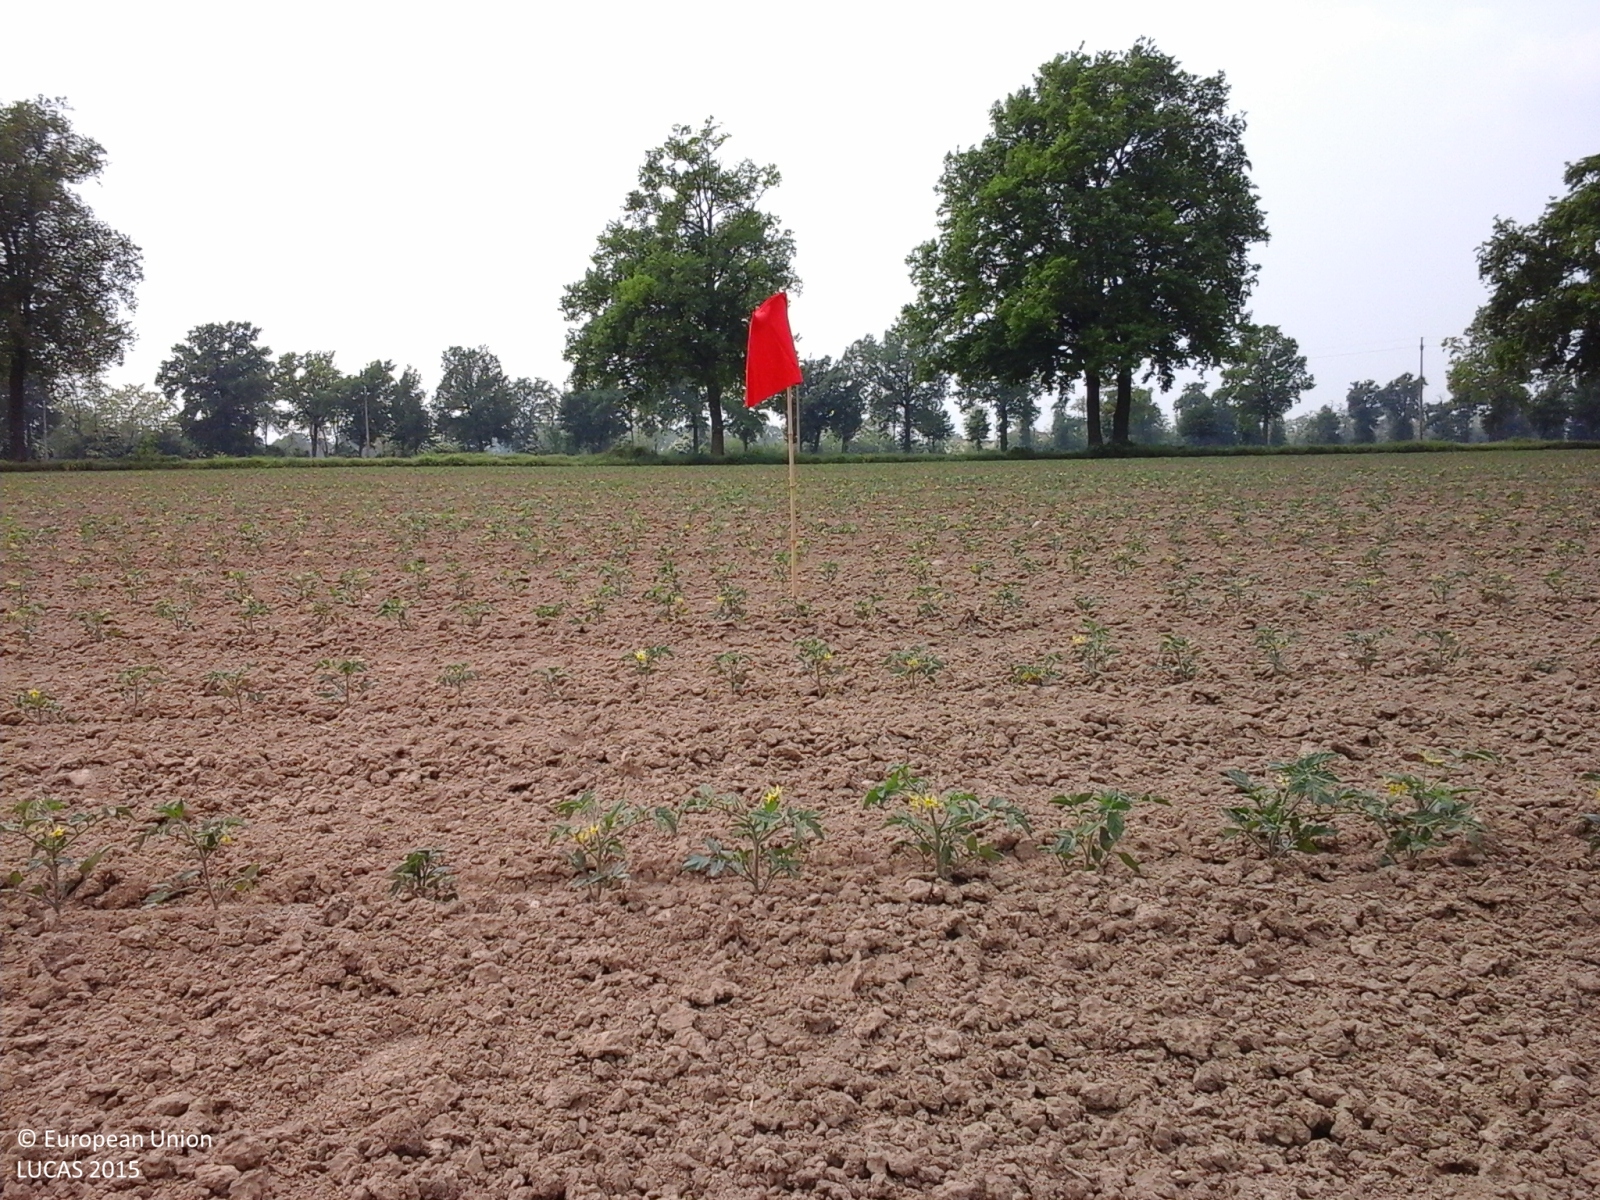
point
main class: Cropland
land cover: Tomatoes
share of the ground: < 10 %
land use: Agriculture (excluding fallow land and kitchen gardens)
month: May
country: IT
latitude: 44.9210
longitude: 8.8241
